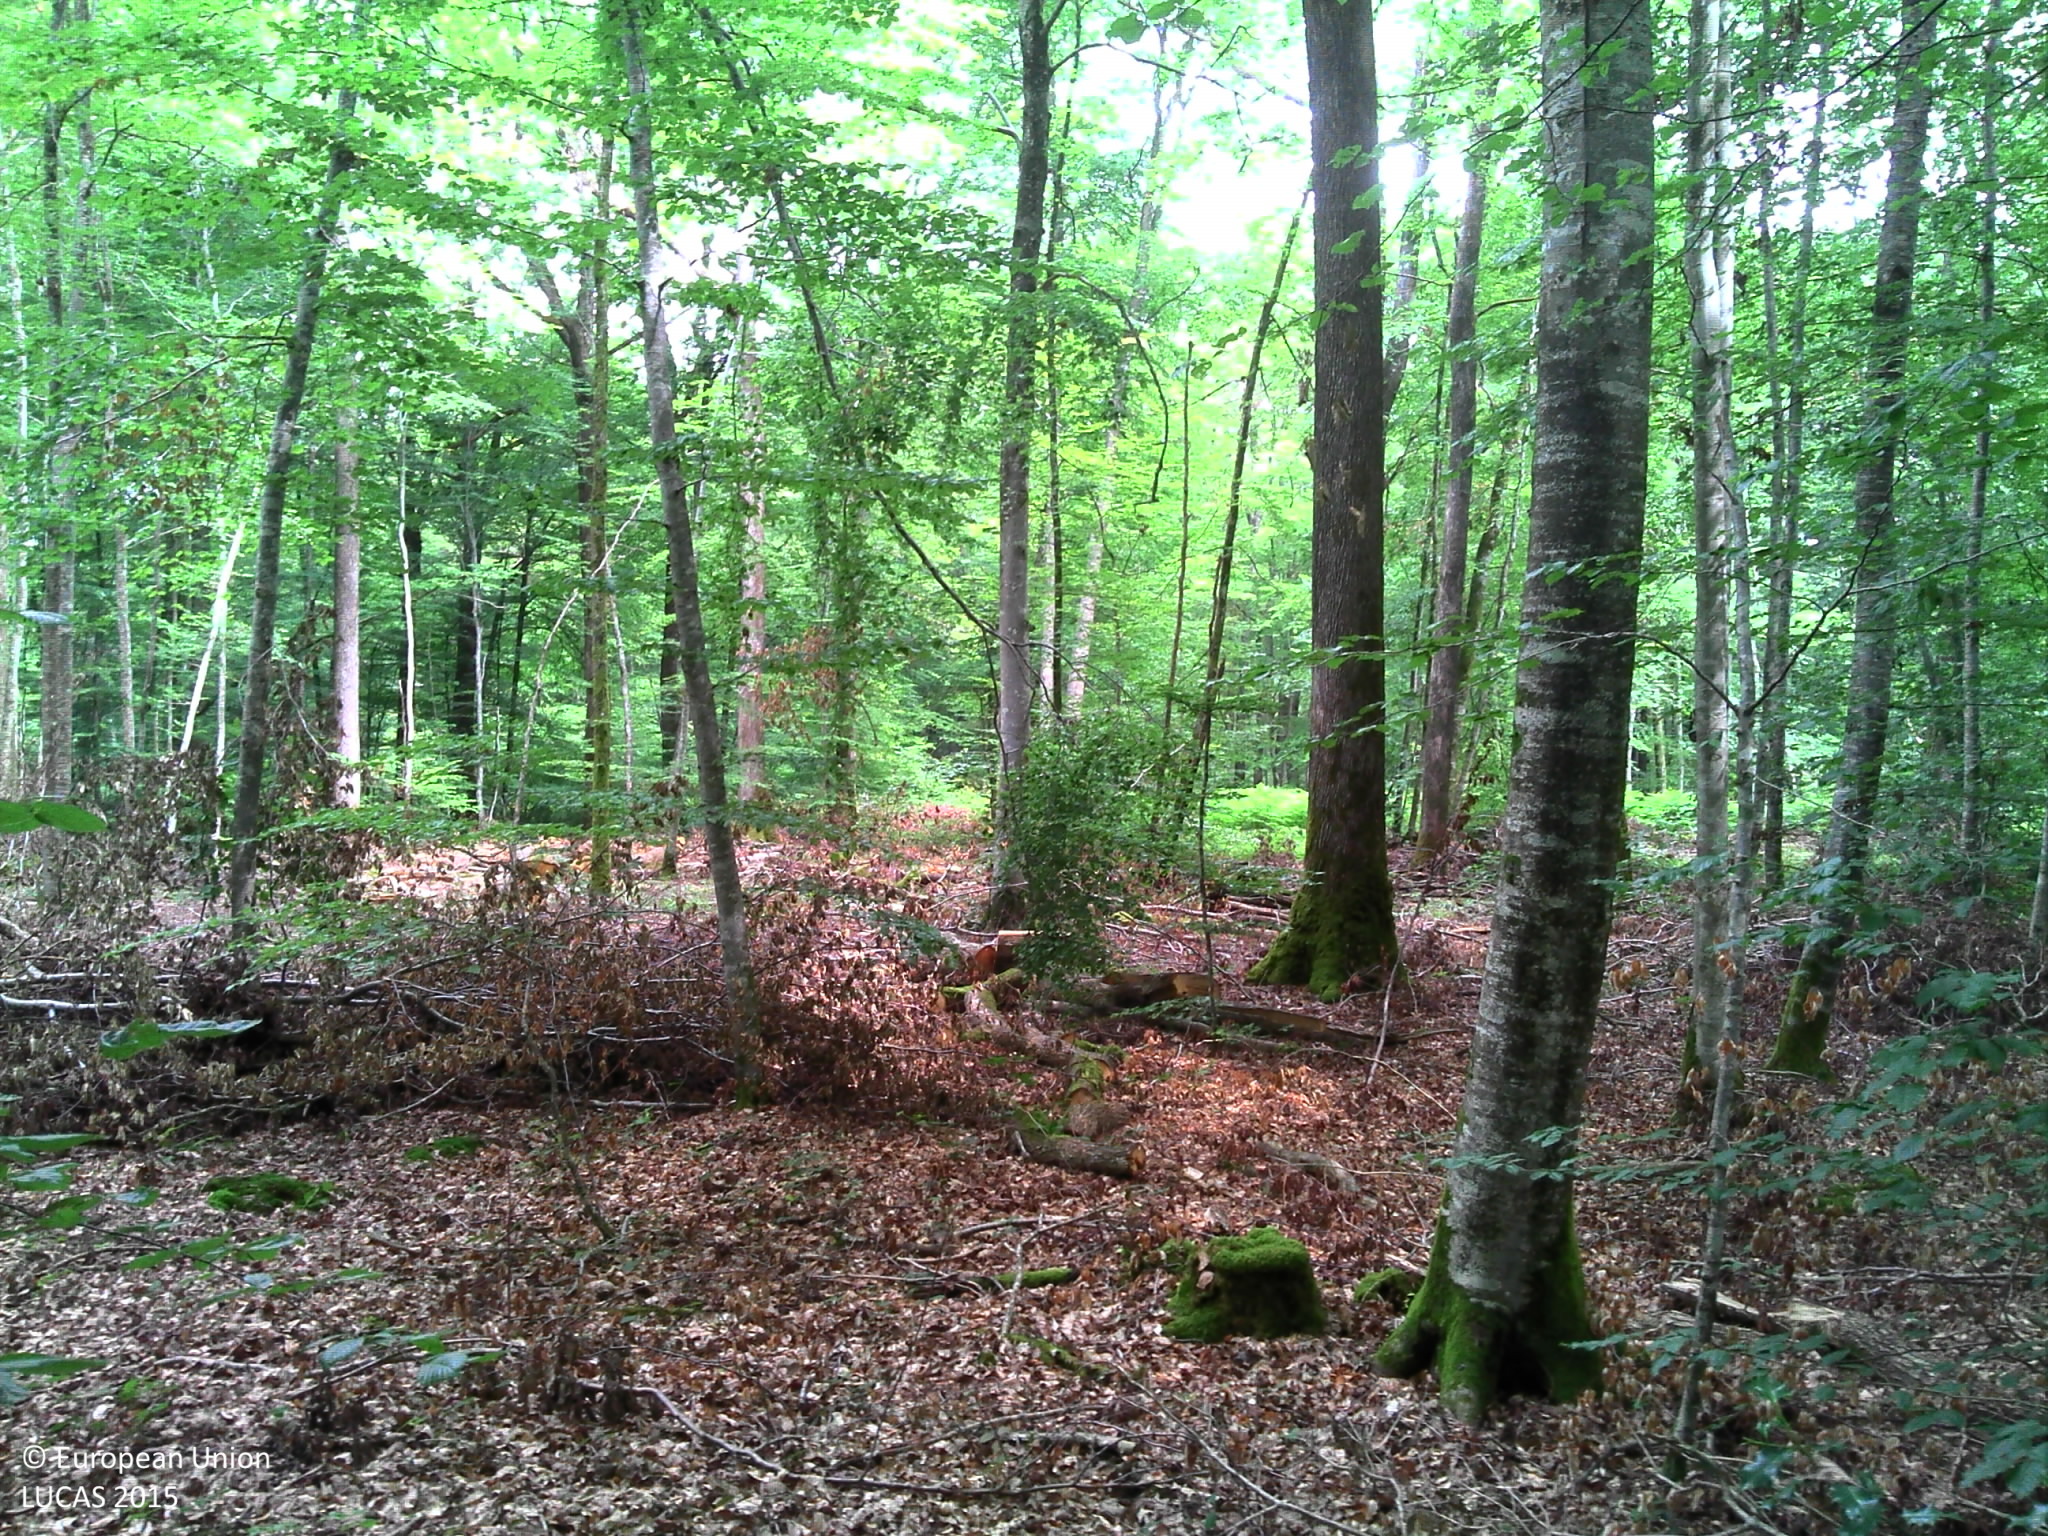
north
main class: Woodland
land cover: Broadleaved woodland
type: acidophilous oak and oak-birch forest
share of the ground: > 75 %
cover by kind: broadleaved forest trees 90 %, shrubs 5 %, lichens and mosses 5 %
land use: Forestry
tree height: > 5 m
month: June
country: FR
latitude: 47.1615
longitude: 3.1497
